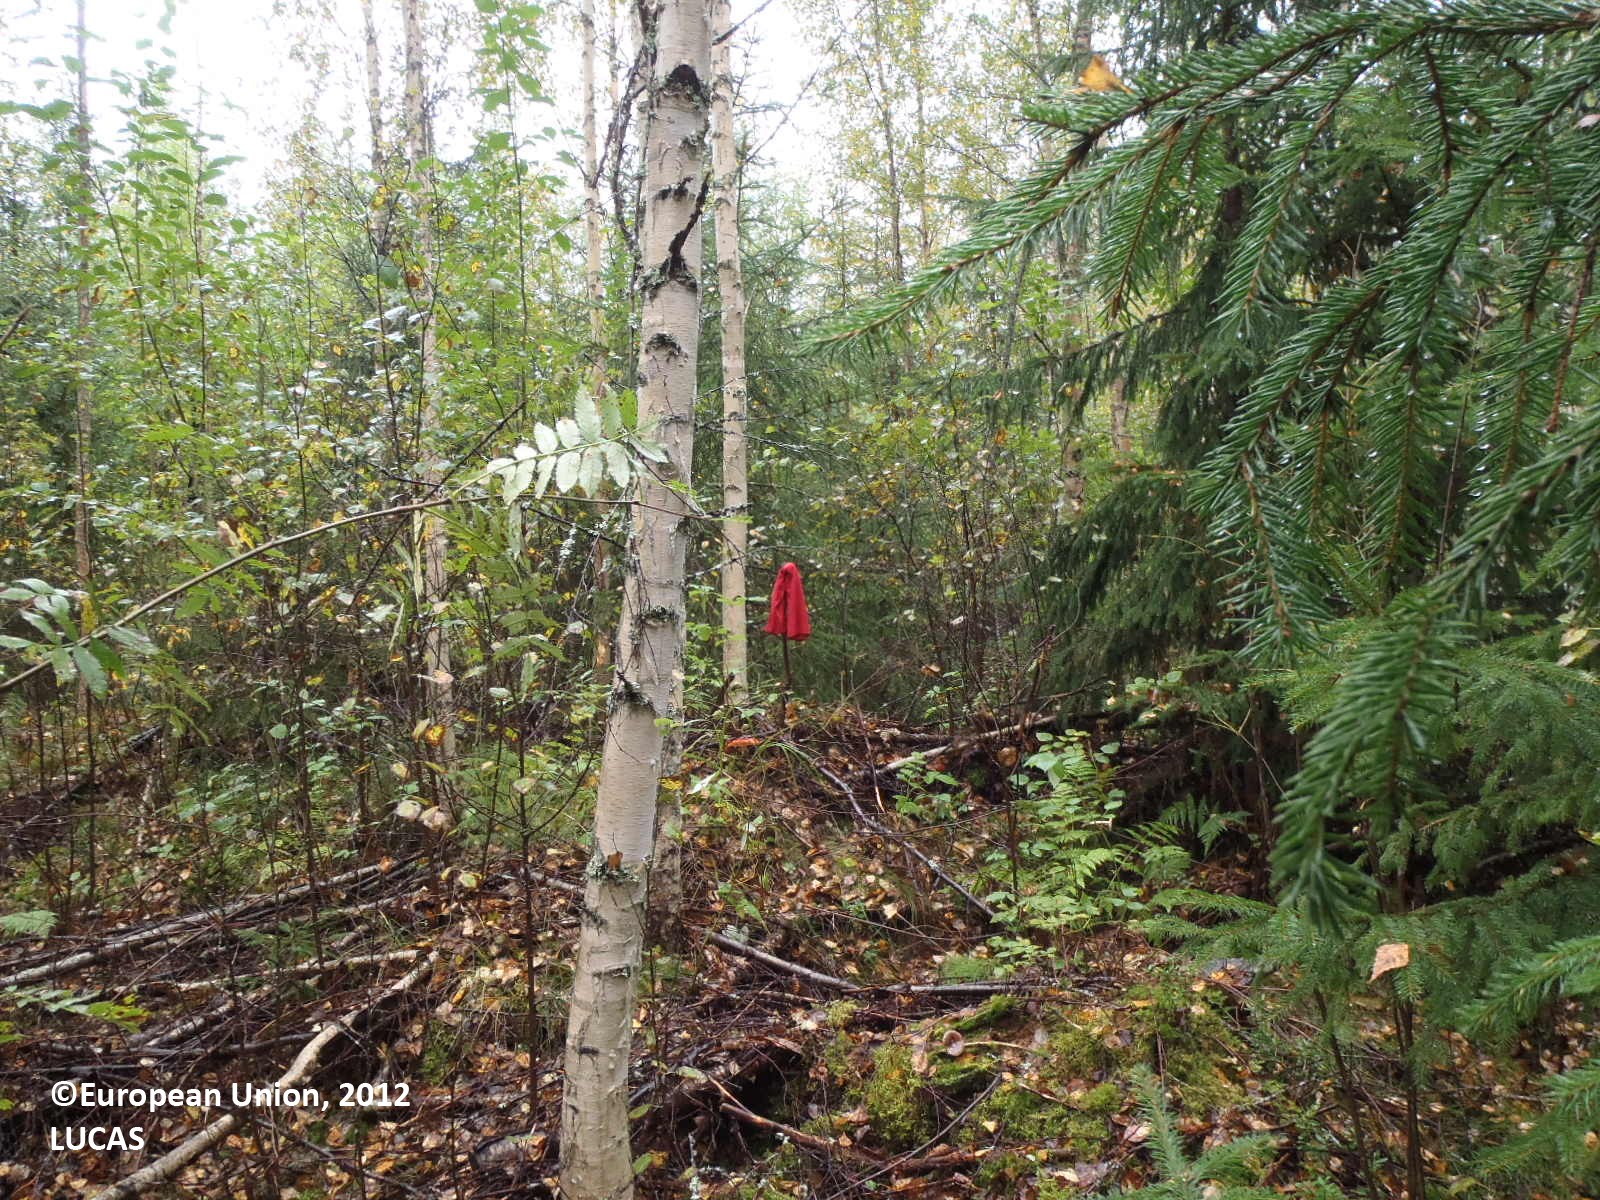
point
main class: Woodland
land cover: Broadleaved woodland
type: boreal forest
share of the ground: > 75 %
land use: Forestry
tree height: > 5 m
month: September
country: FI
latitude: 61.6049
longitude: 22.5995
